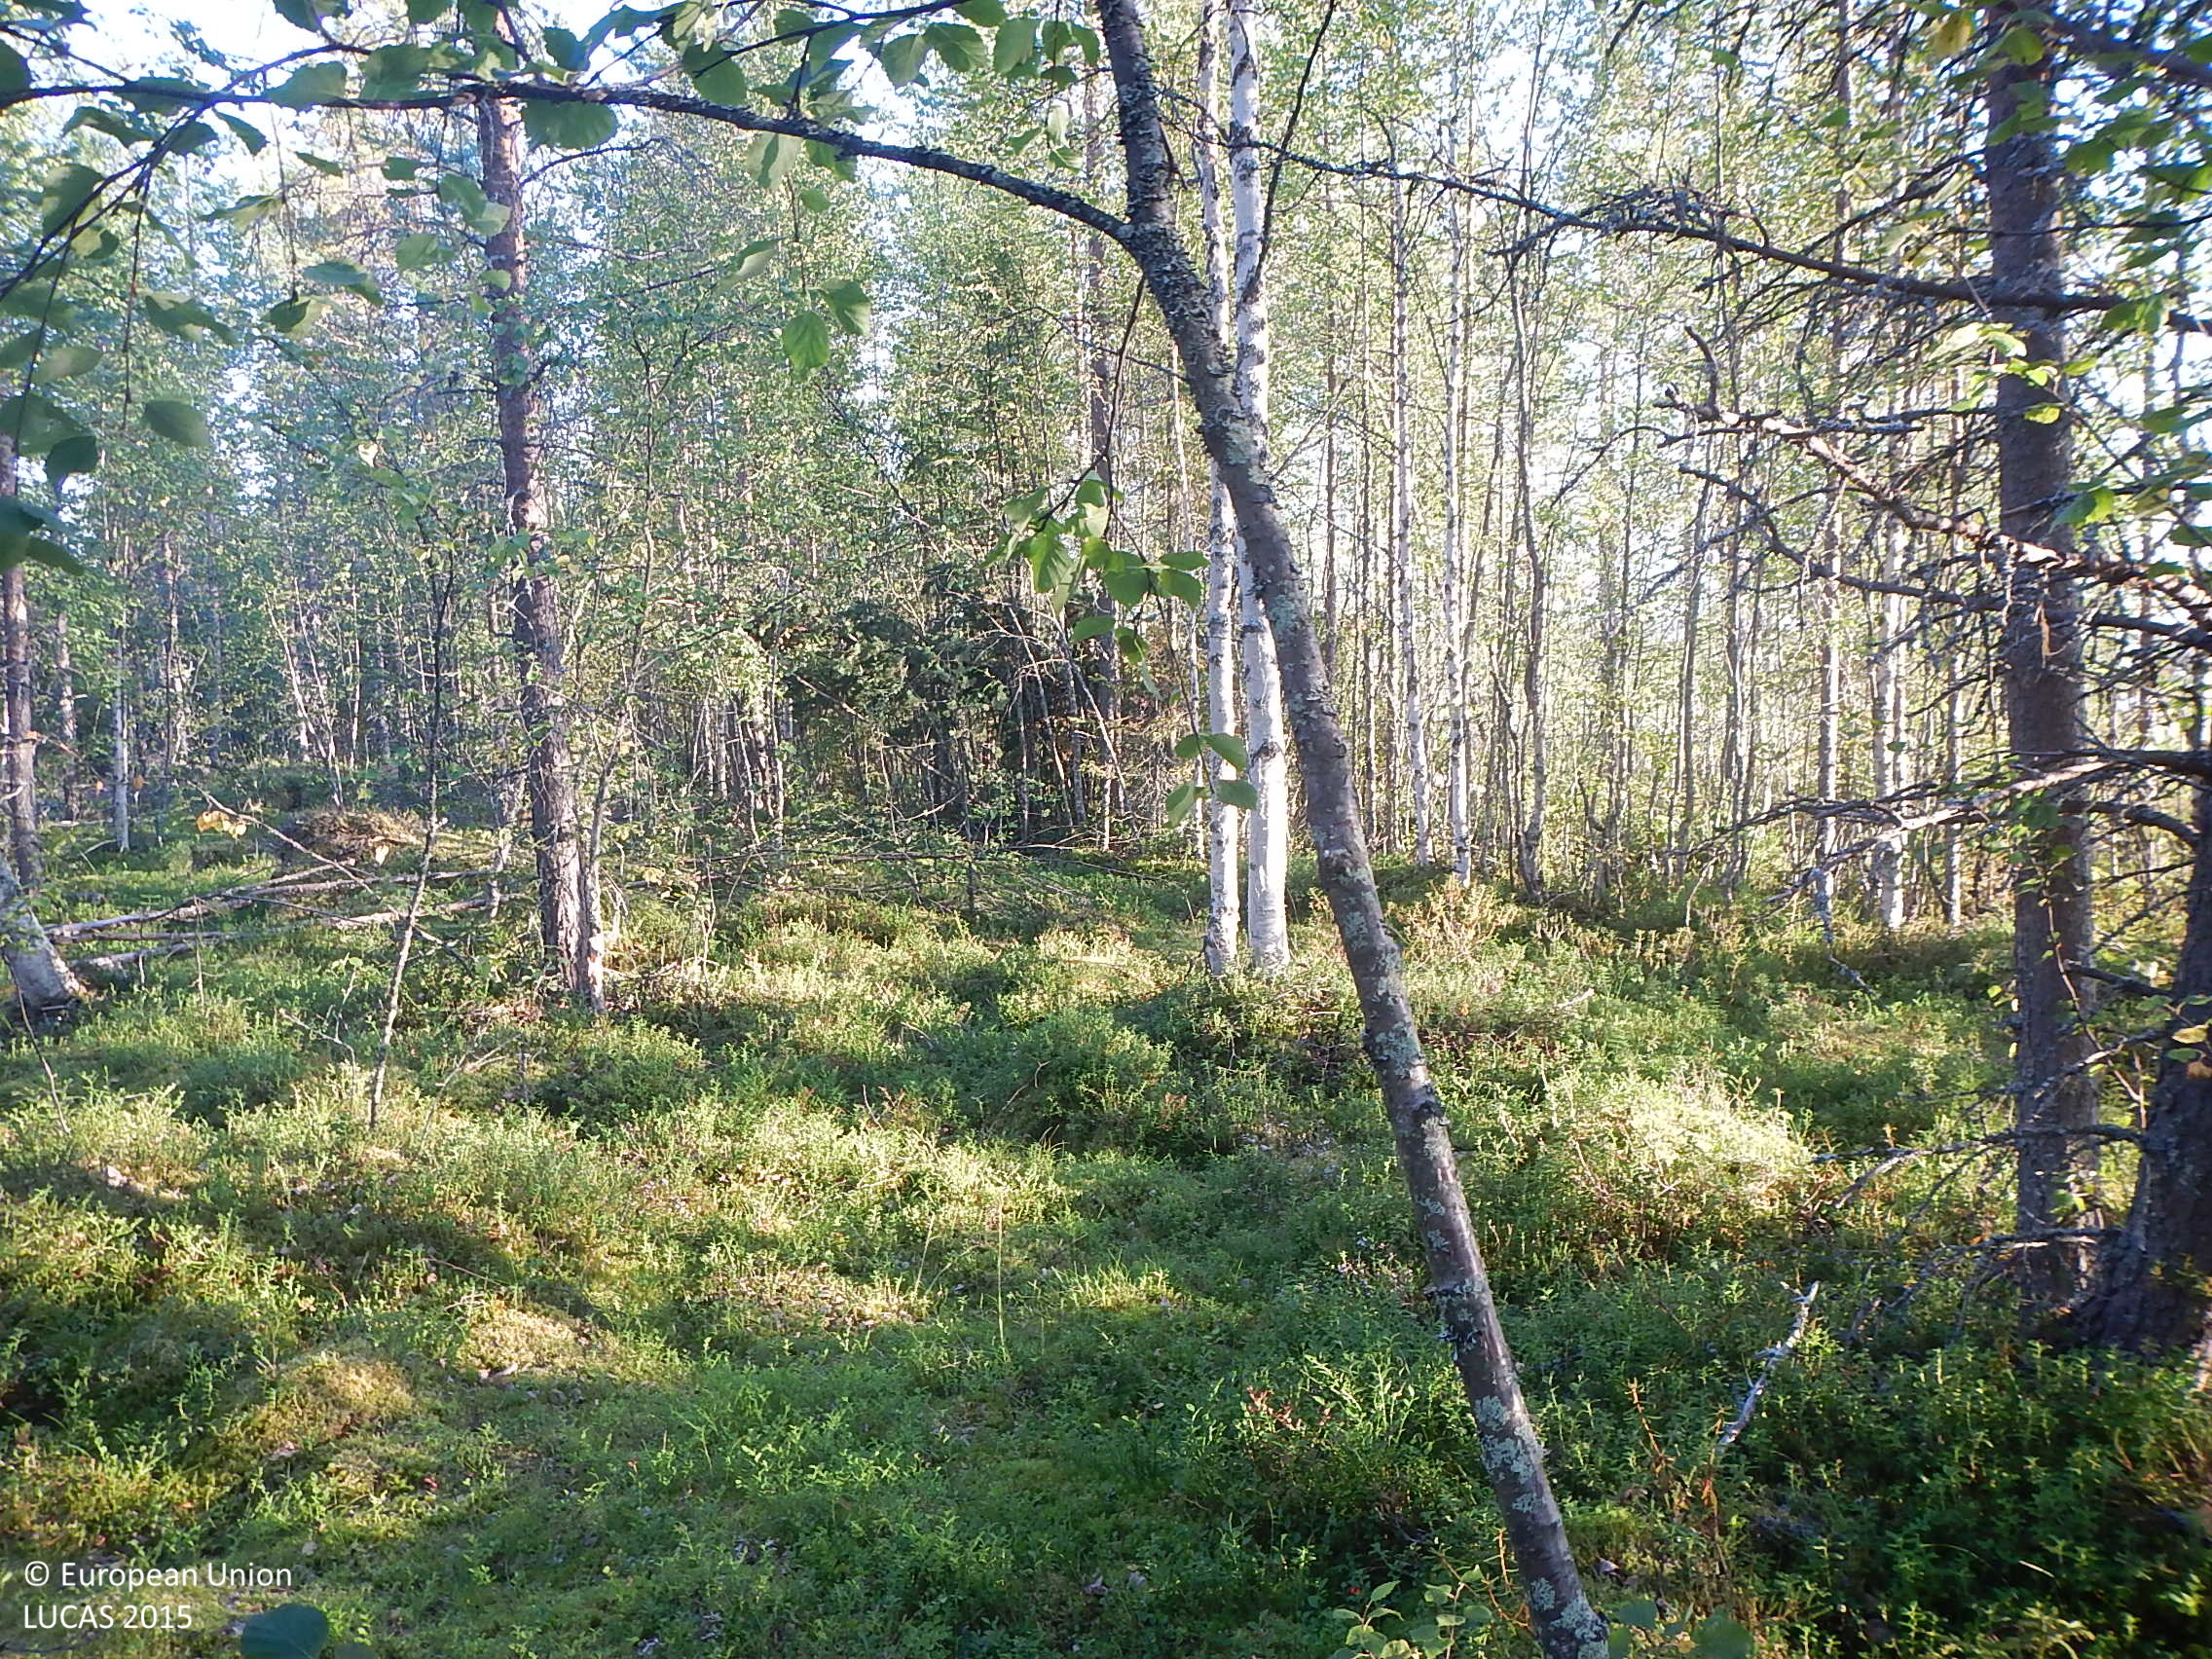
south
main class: Woodland
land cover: Pine dominated mixed woodland
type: boreal forest
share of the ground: > 75 %
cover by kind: coniferous forest trees 50 %, broadleaved forest trees 30 %, shrubs 10 %, lichens and mosses 10 %
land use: Forestry
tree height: > 5 m
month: August
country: FI
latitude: 66.4516
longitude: 28.1930
